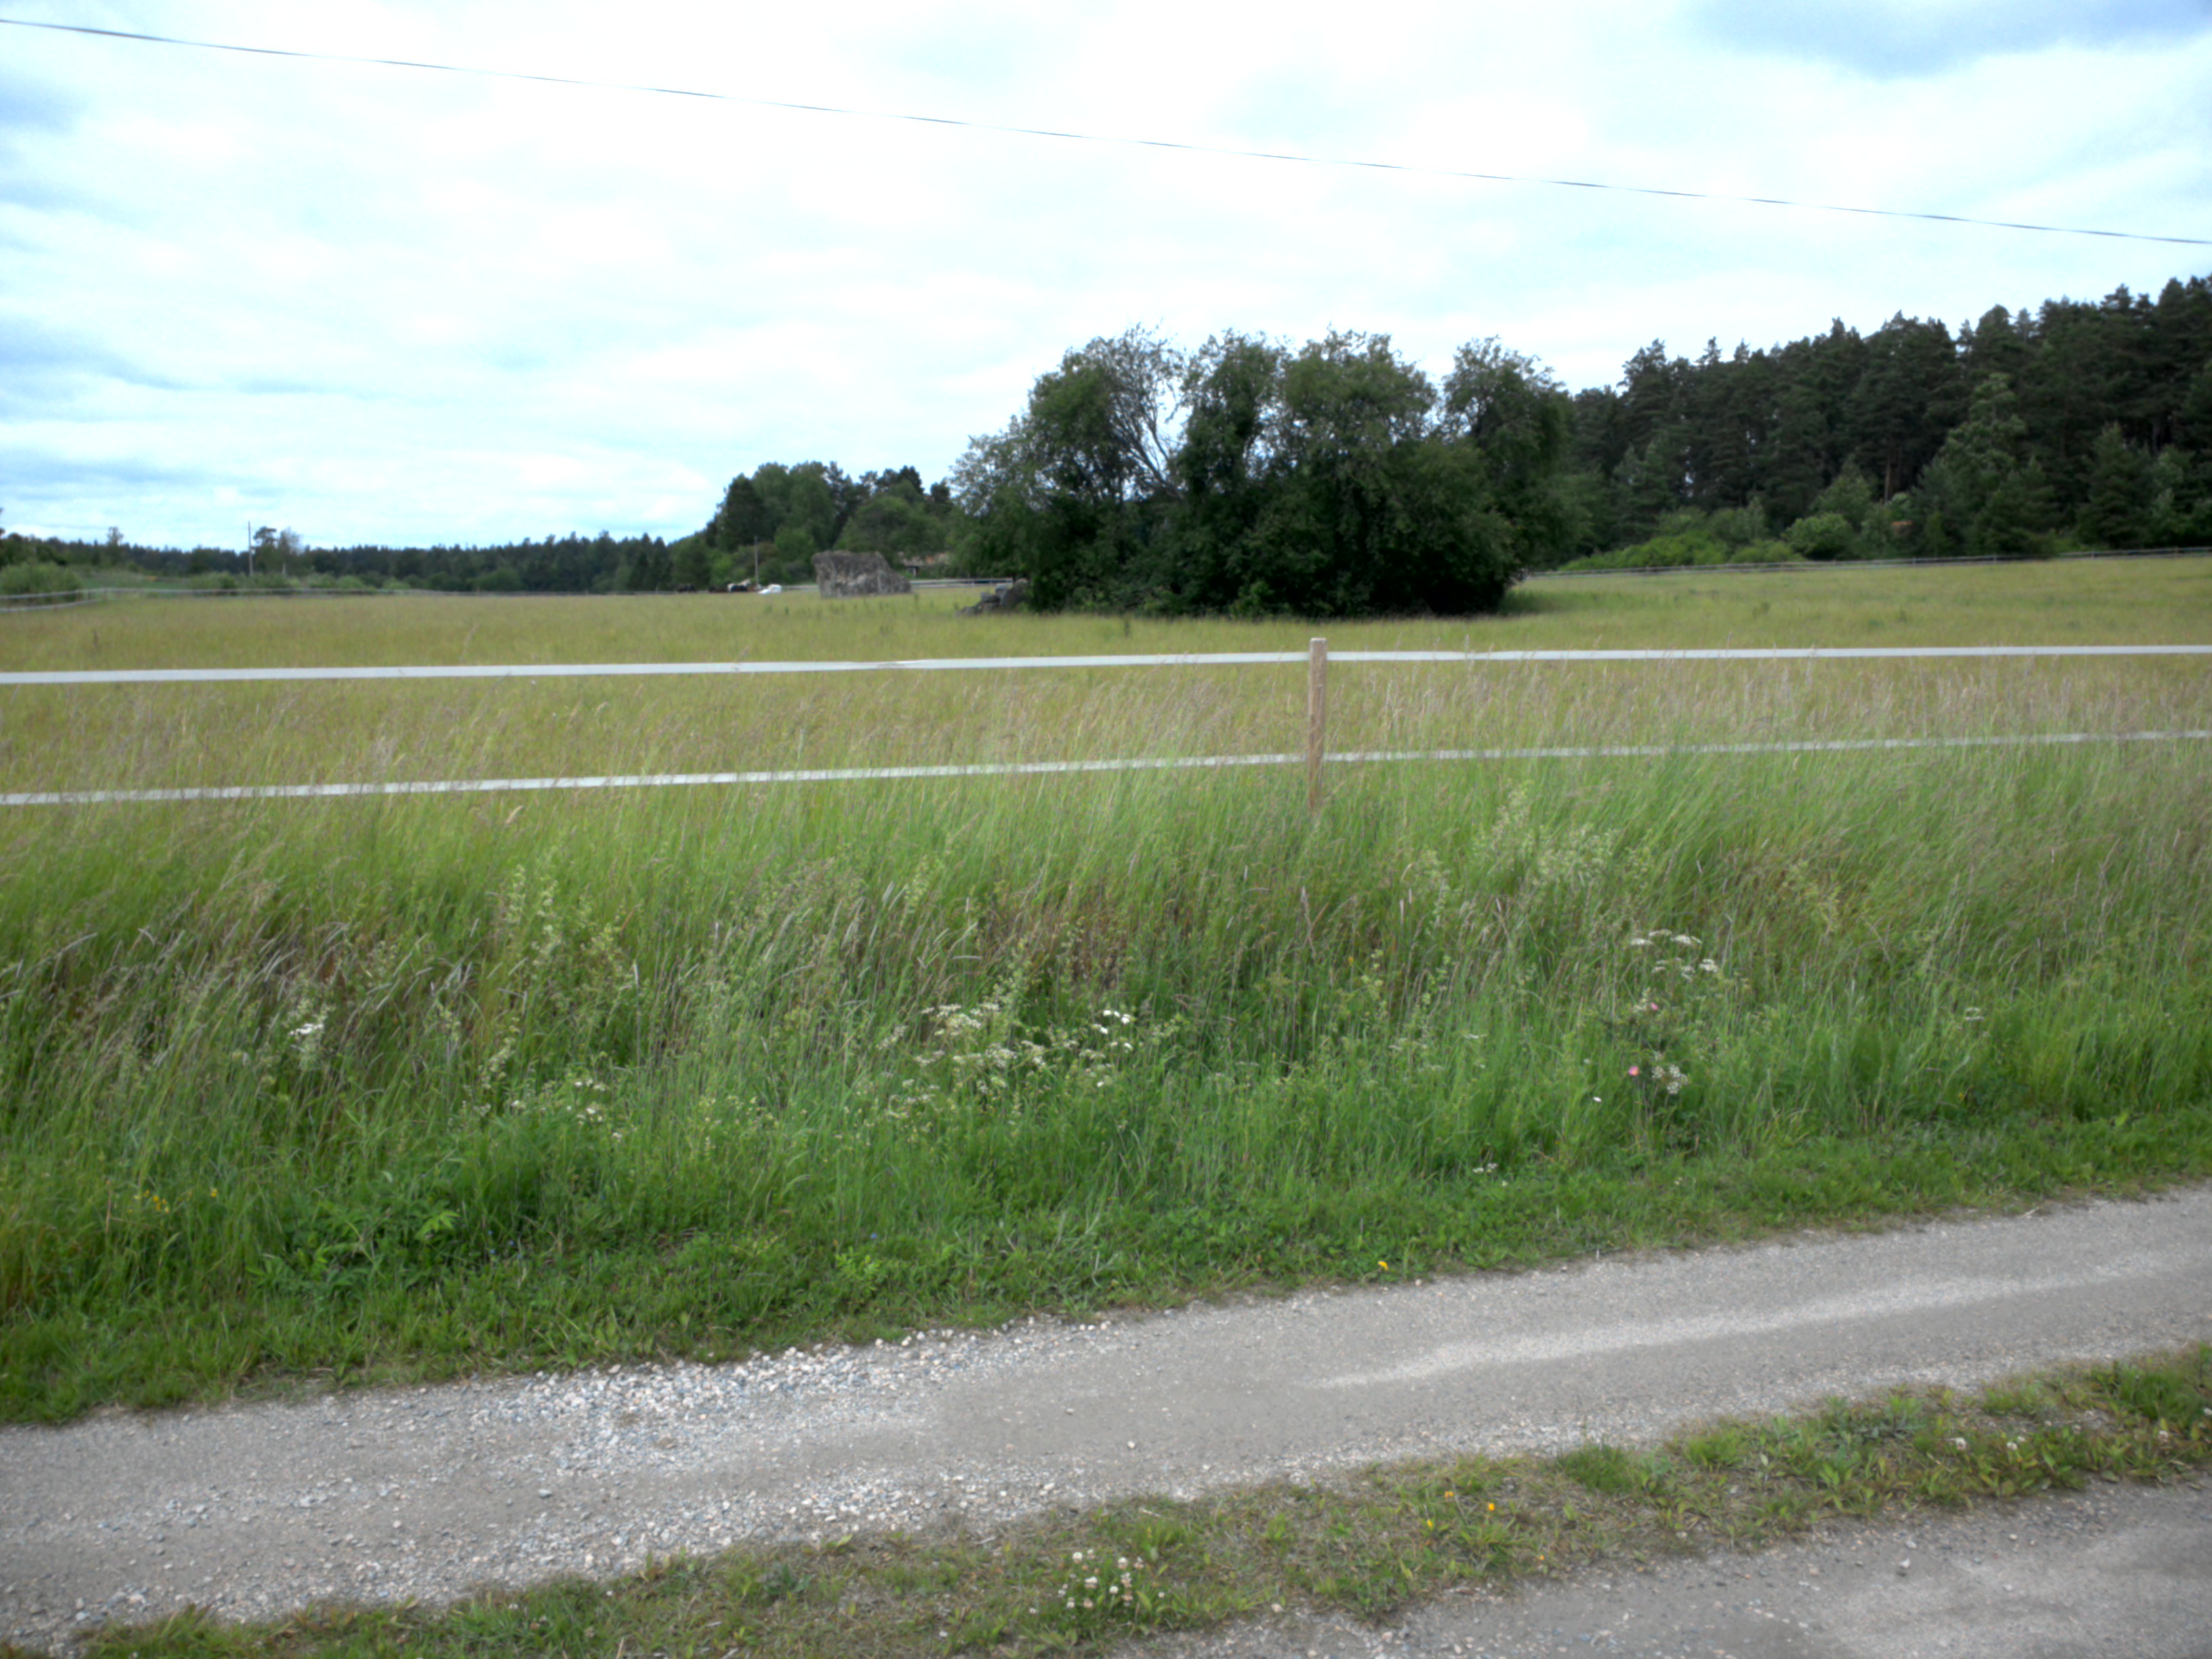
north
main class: Cropland
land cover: Other fibre and oleaginous crops
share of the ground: > 75 %
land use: Agriculture (excluding fallow land and kitchen gardens)
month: June
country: SE
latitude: 59.2780
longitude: 17.4546
